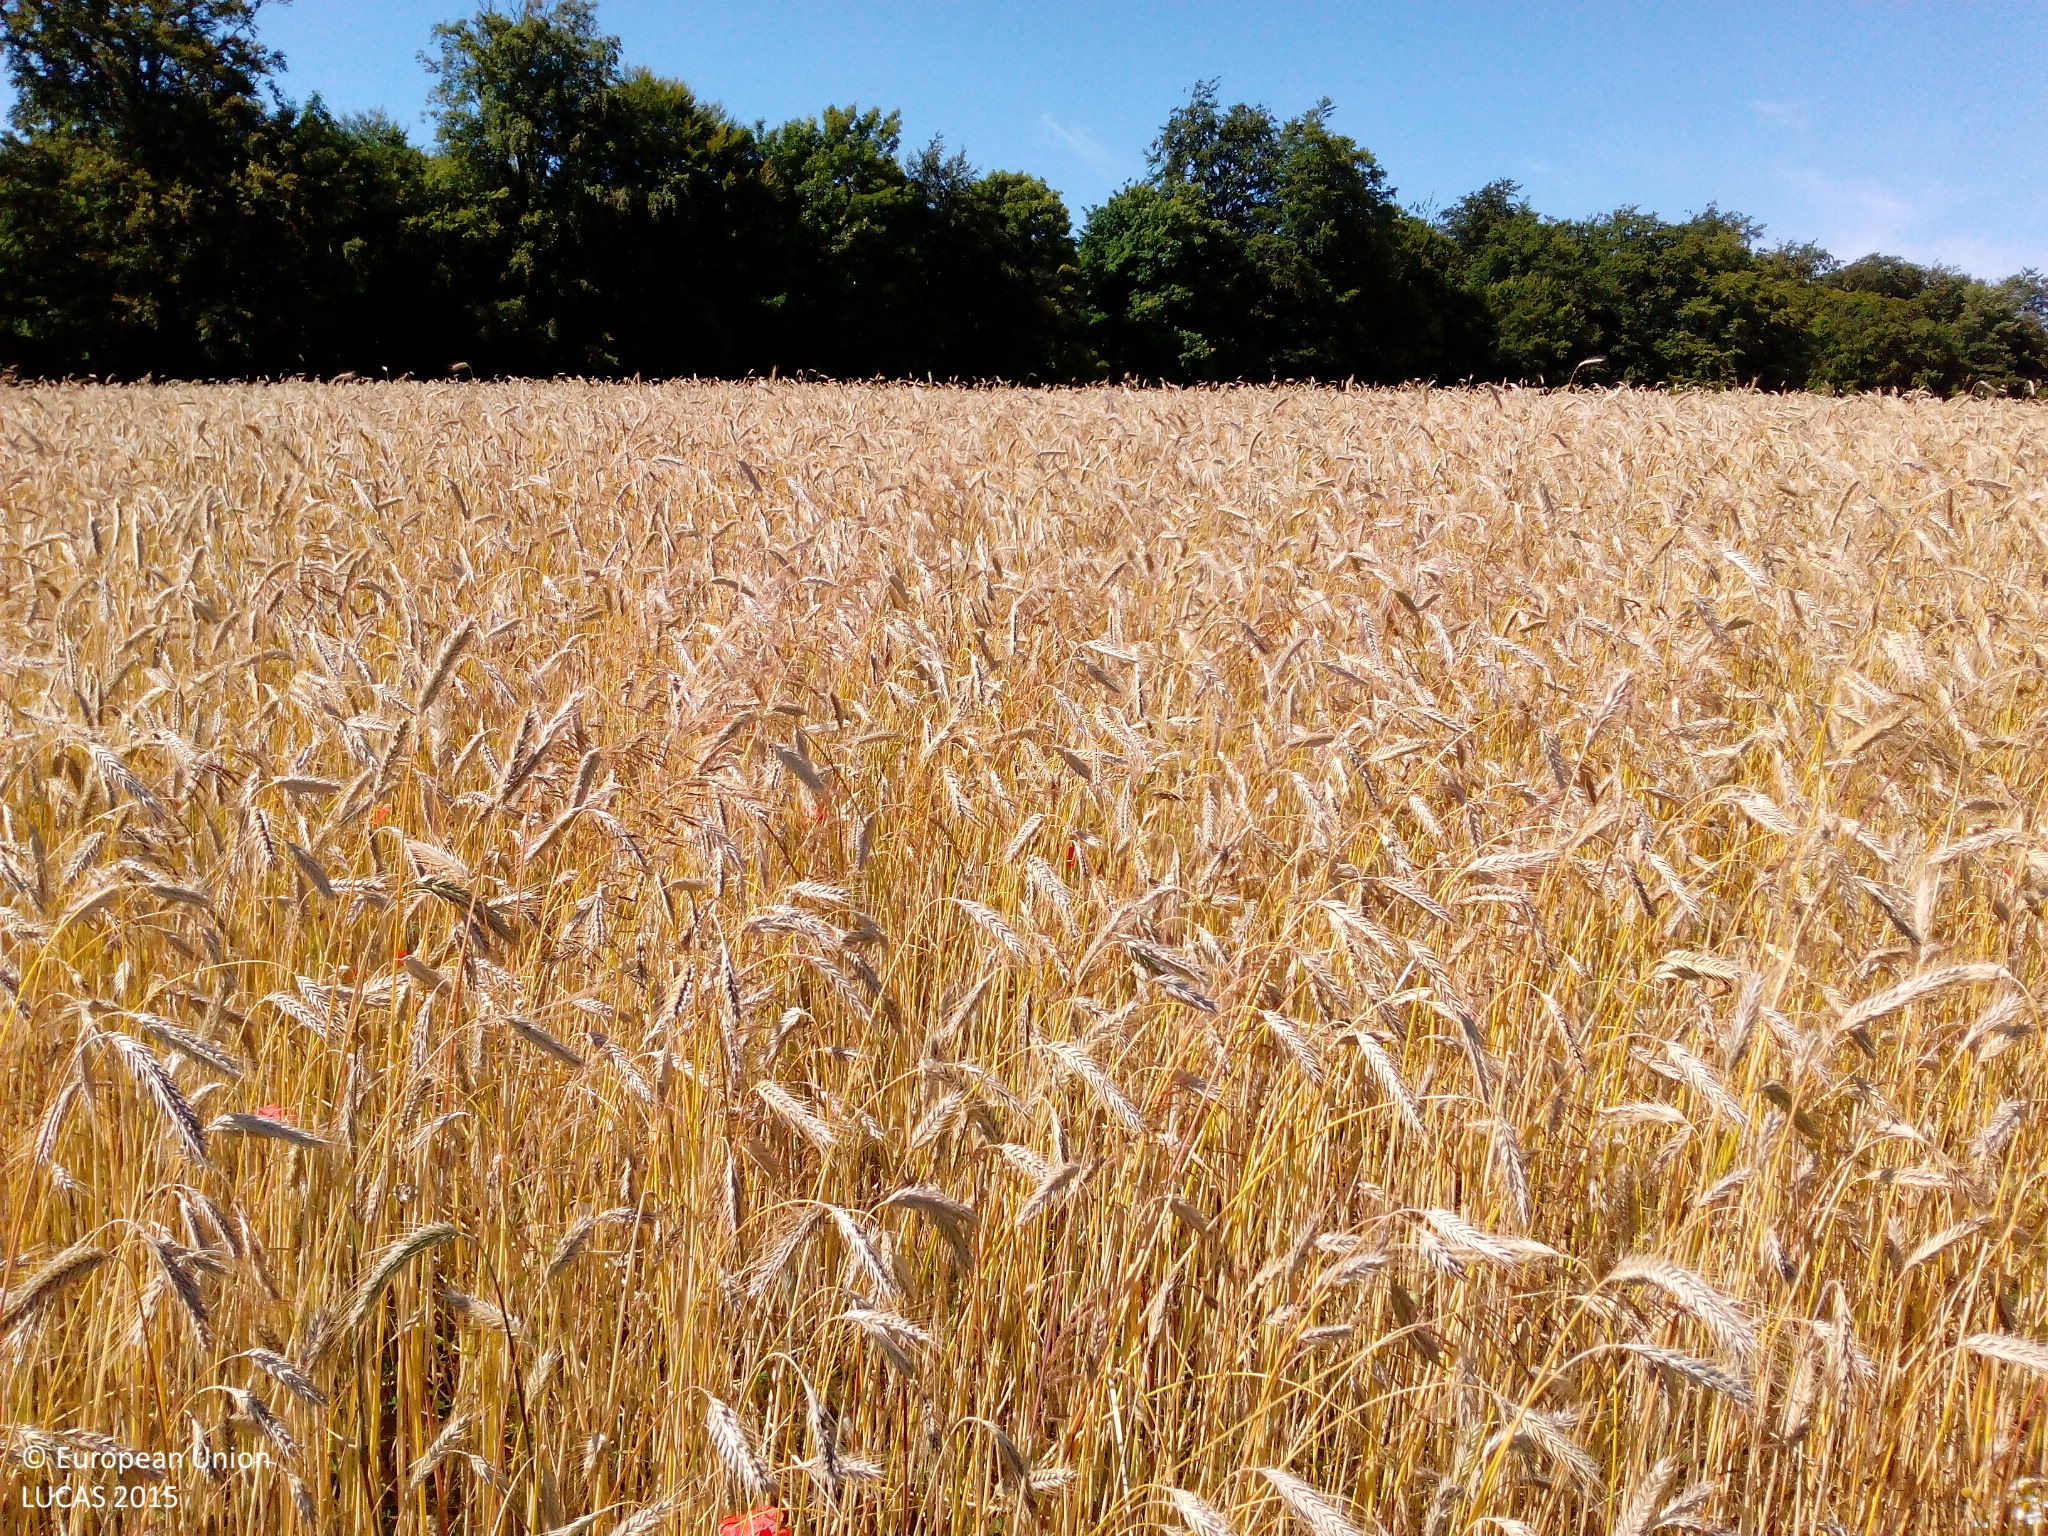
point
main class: Cropland
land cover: Rye
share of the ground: > 75 %
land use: Agriculture (excluding fallow land and kitchen gardens)
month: August
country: DK
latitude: 55.5806
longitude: 11.8861
